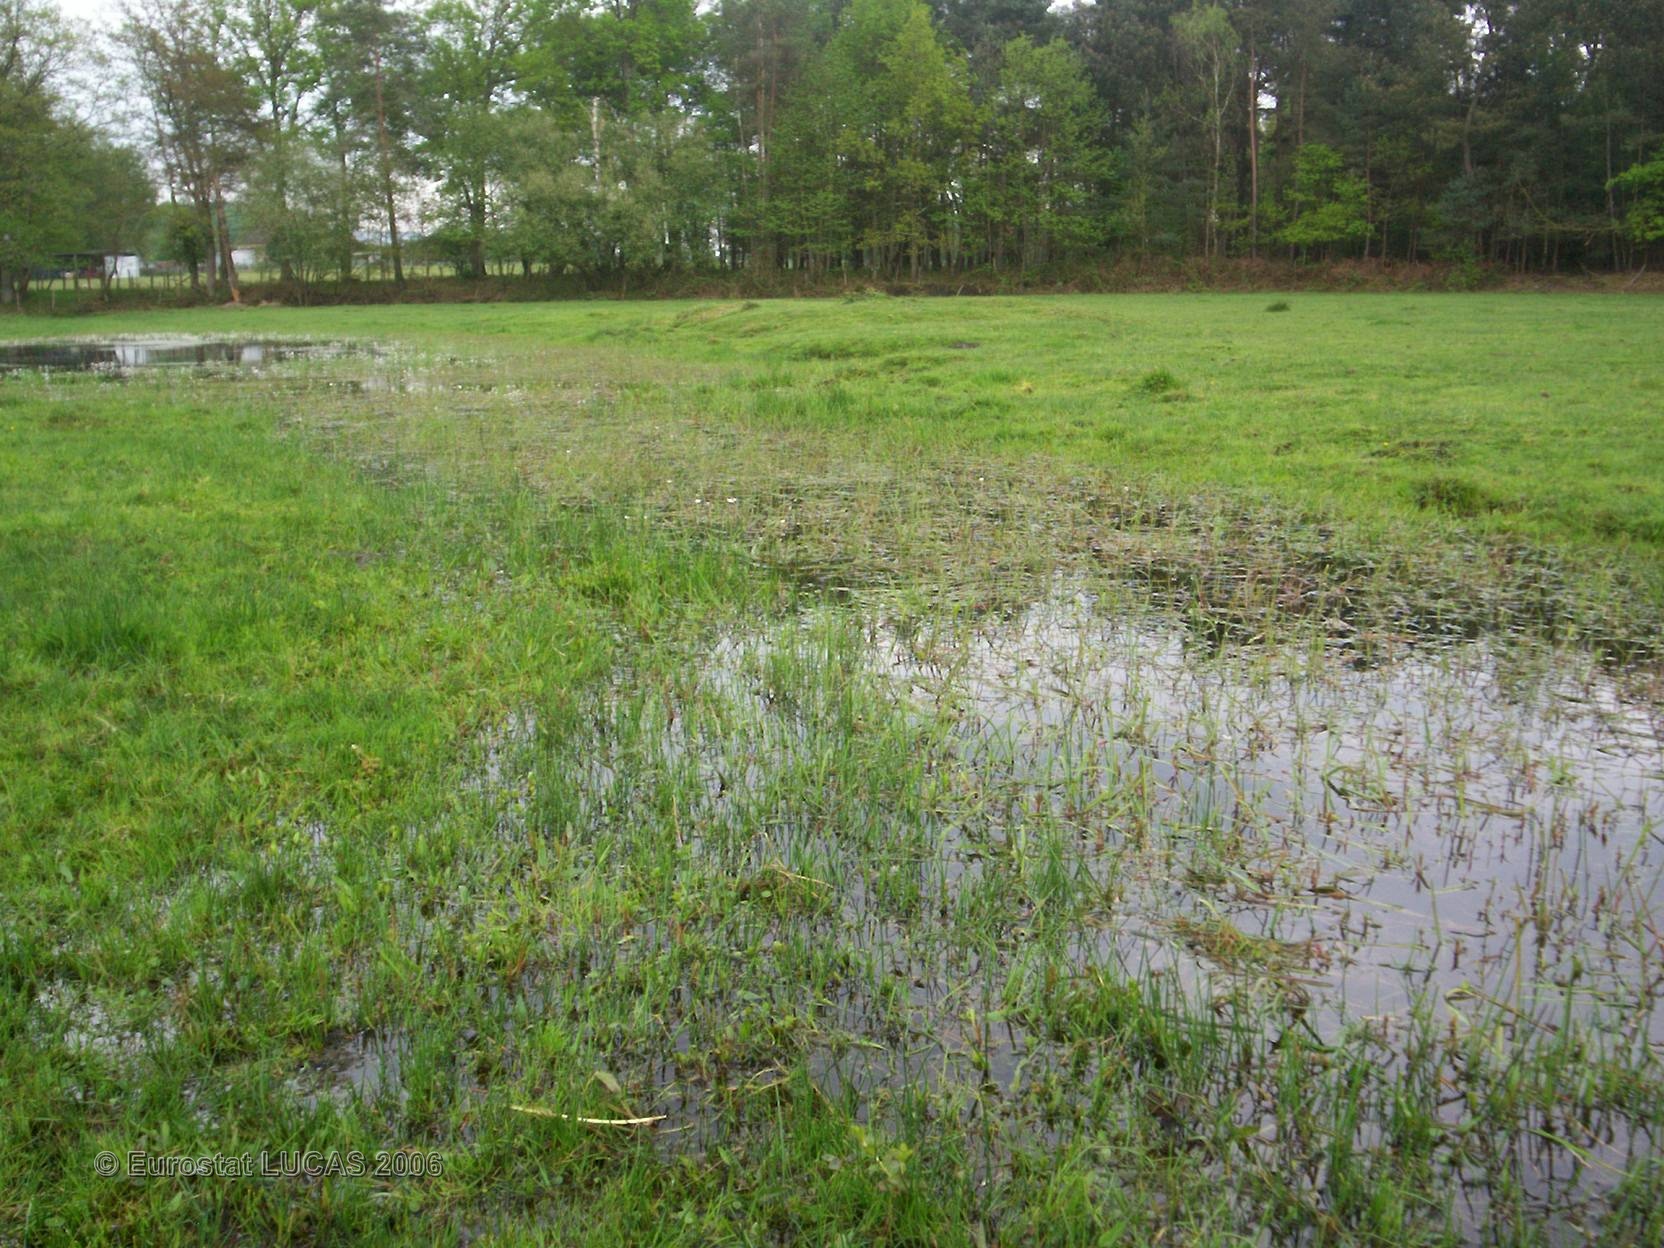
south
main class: Grassland
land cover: Grassland without tree/shrub cover
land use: Agriculture (excluding fallow land and kitchen gardens)
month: May
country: FR
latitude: 47.9573
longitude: 0.2929
